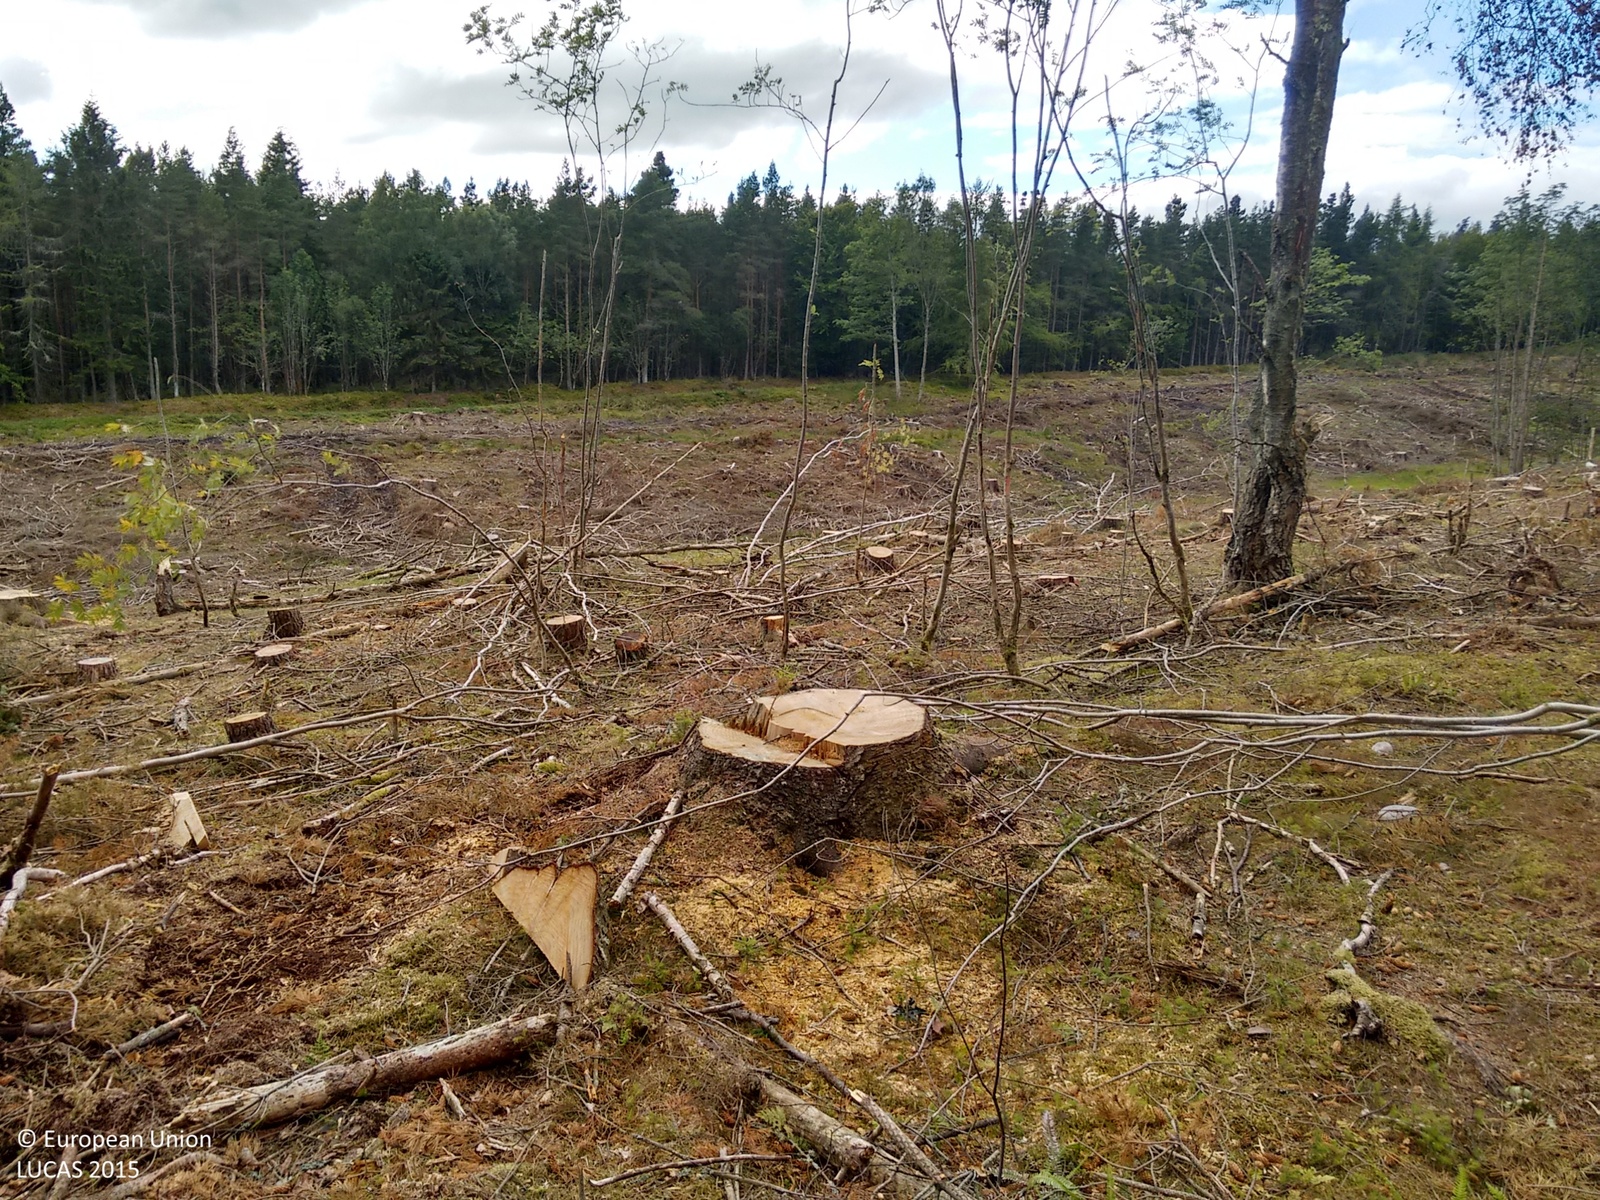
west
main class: Grassland
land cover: Grassland with sparse tree/shrub cover
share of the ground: > 75 %
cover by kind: herbaceous plants 50 %, lichens and mosses 25 %, unconsolidated bare surface 20 %, broadleaved forest trees 5 %
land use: Forestry
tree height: > 5 m
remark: Clear cut
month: August
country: GB
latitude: 57.6514
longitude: -2.8771
